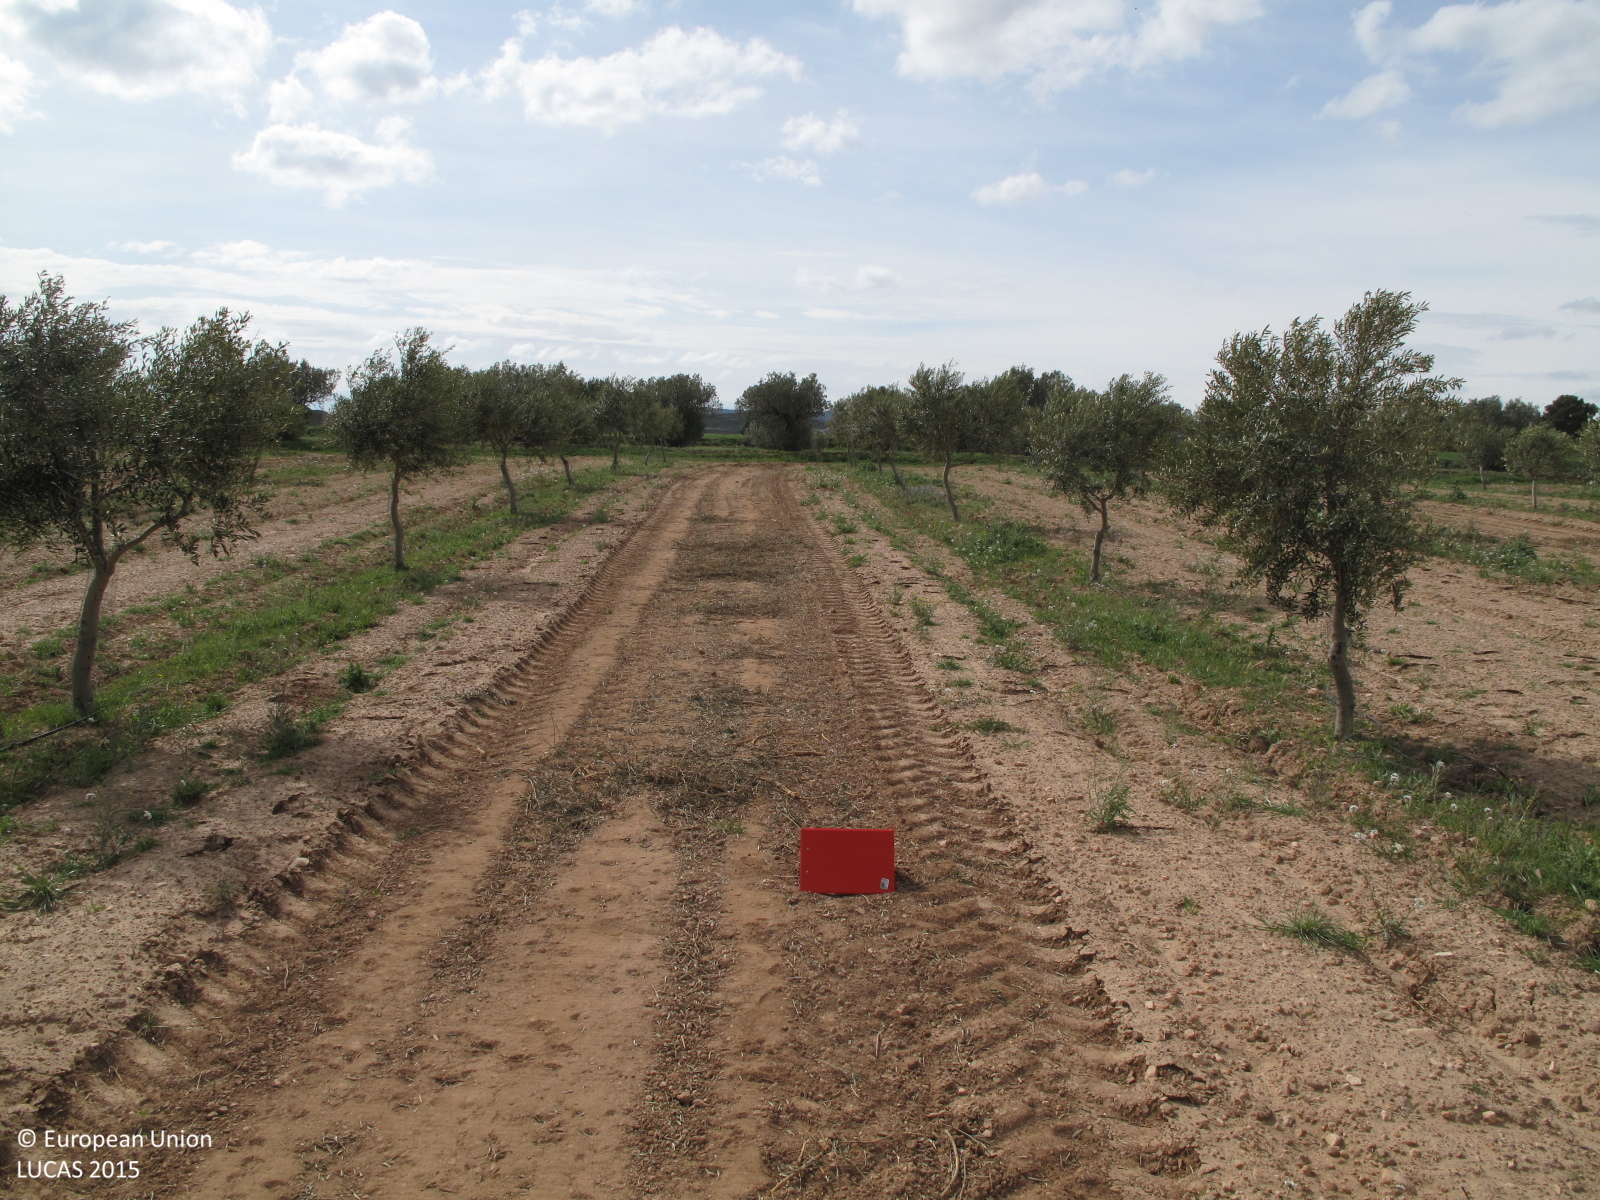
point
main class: Cropland
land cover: Olive groves
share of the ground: < 10 %
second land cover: Spontaneously vegetated surfaces
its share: < 10 %
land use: Agriculture (excluding fallow land and kitchen gardens)
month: April
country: ES
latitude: 38.6649
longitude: -0.9666
